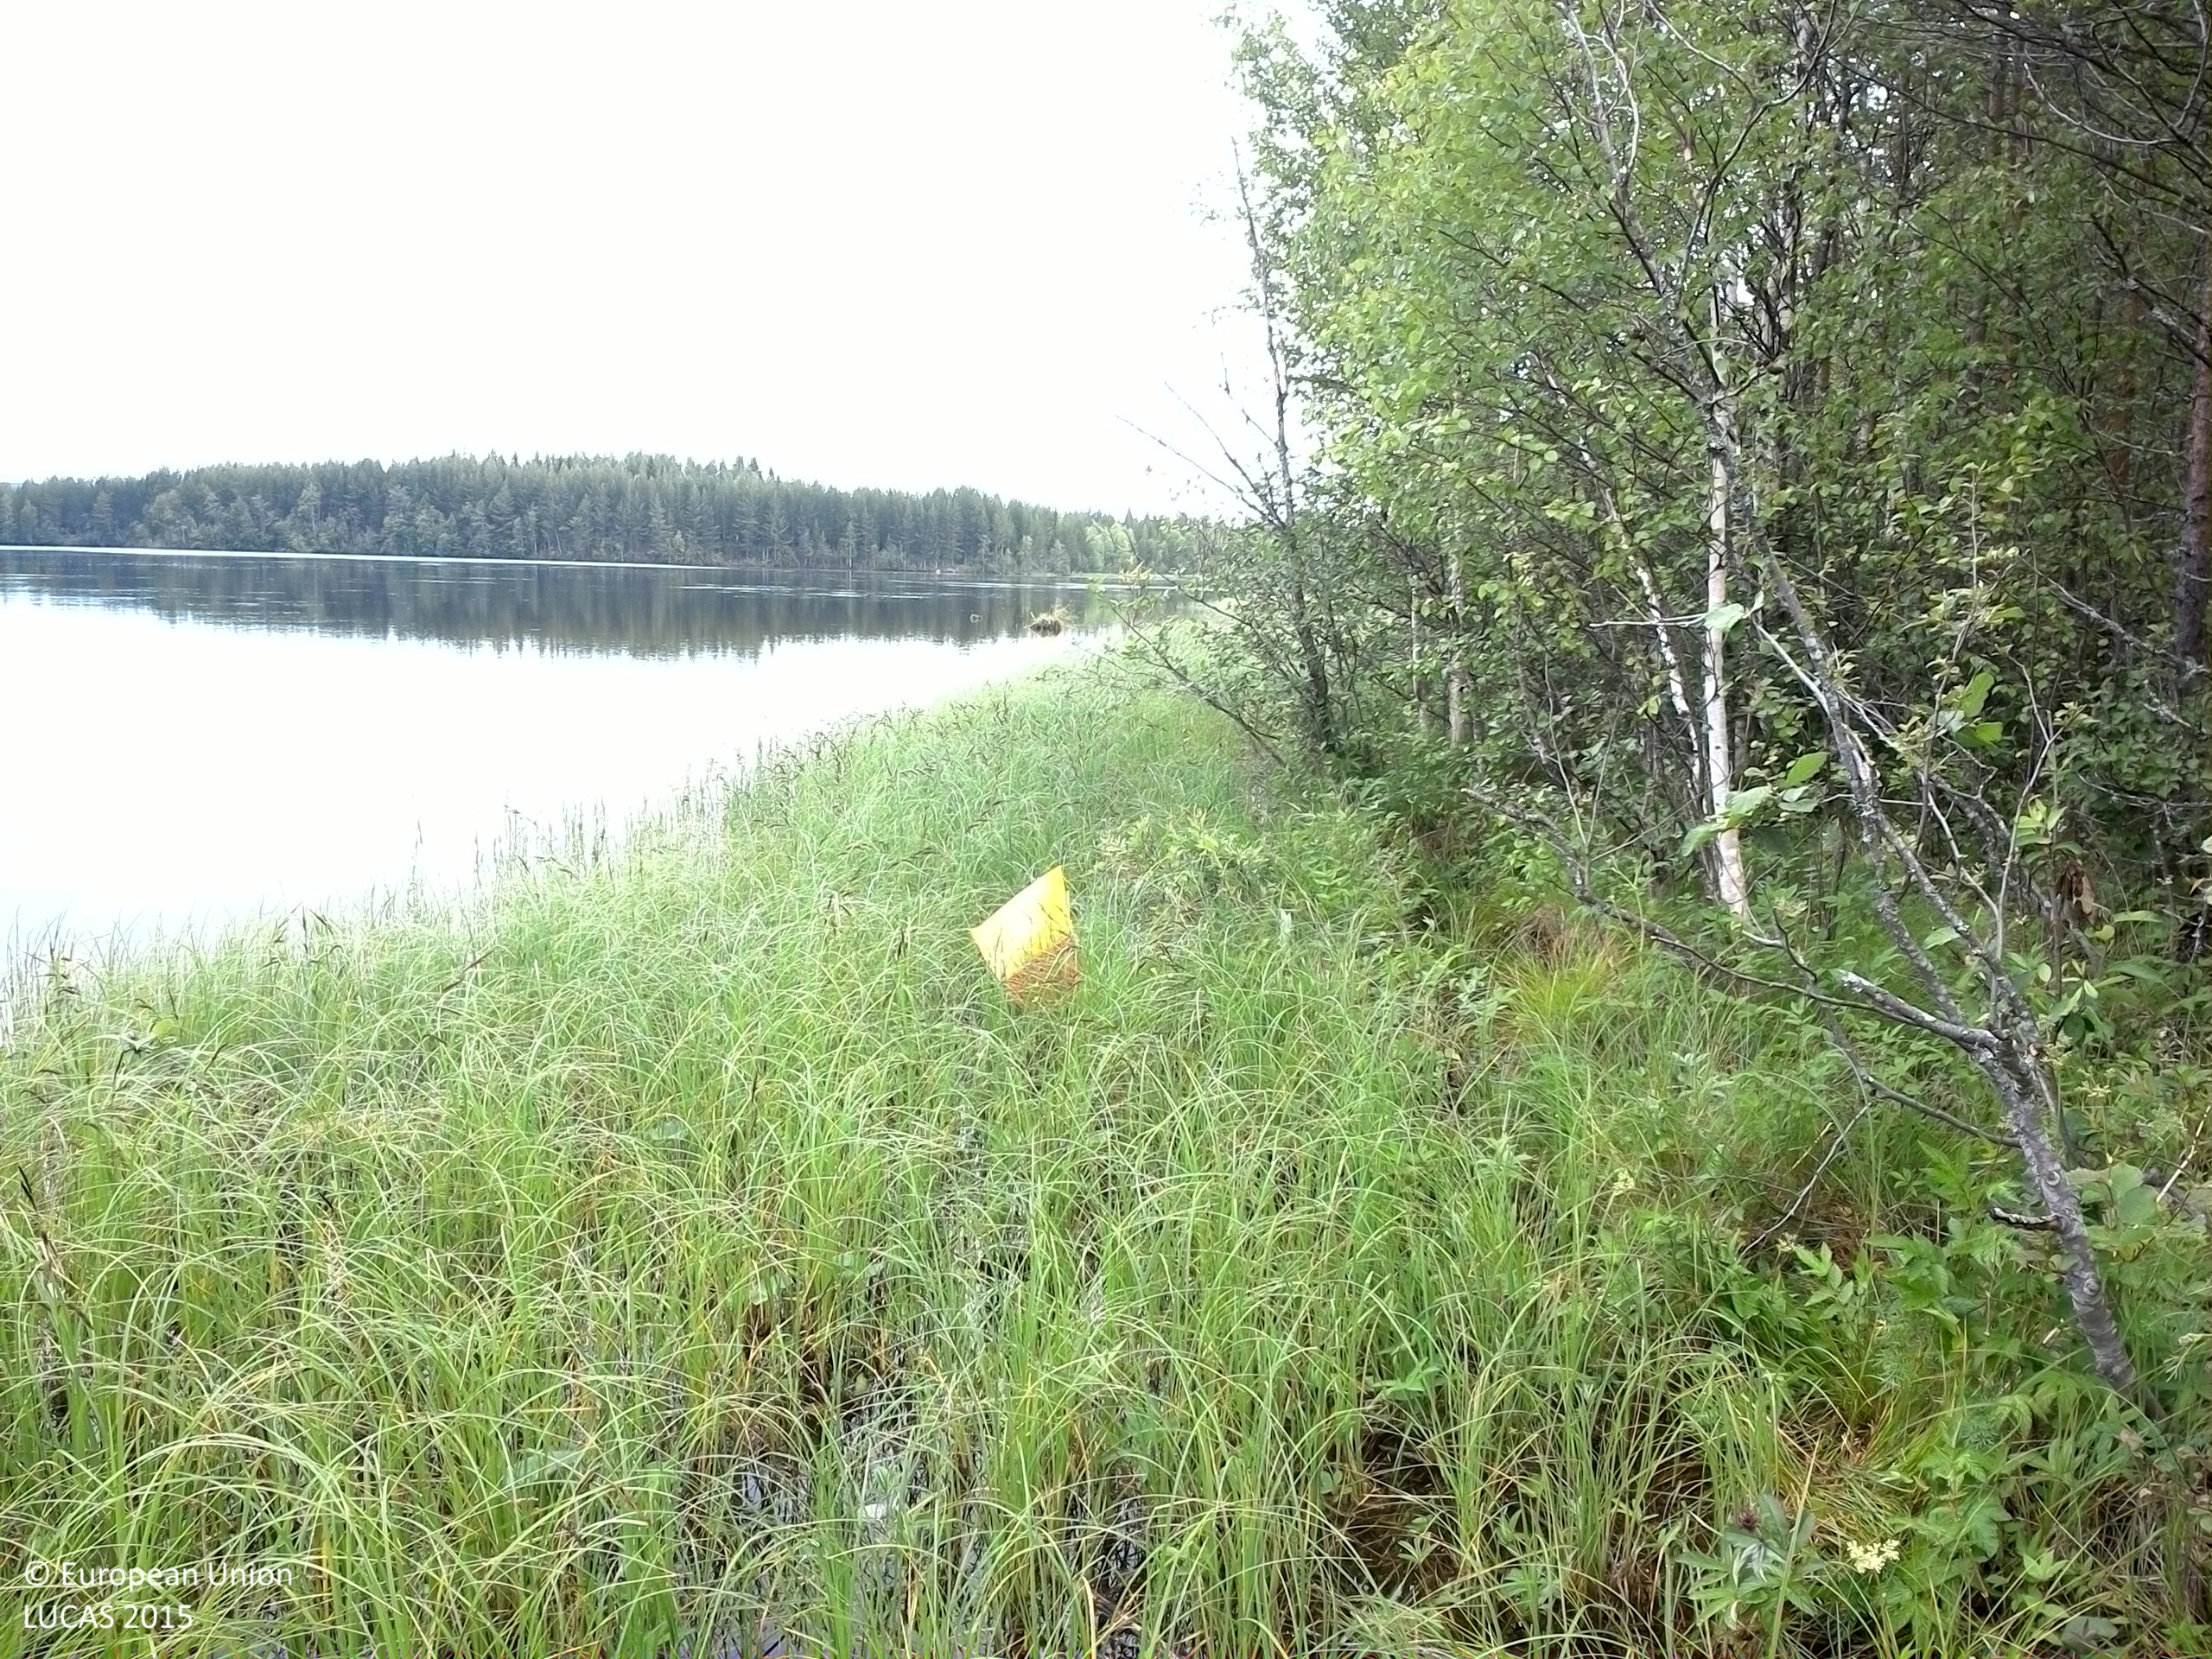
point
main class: Grassland
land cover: Grassland without tree/shrub cover
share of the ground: > 75 %
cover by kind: herbaceous plants 85 %
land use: Semi-natural and natural areas not in use
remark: Temporary flooded
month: July
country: SE
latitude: 63.8560
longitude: 17.1519
